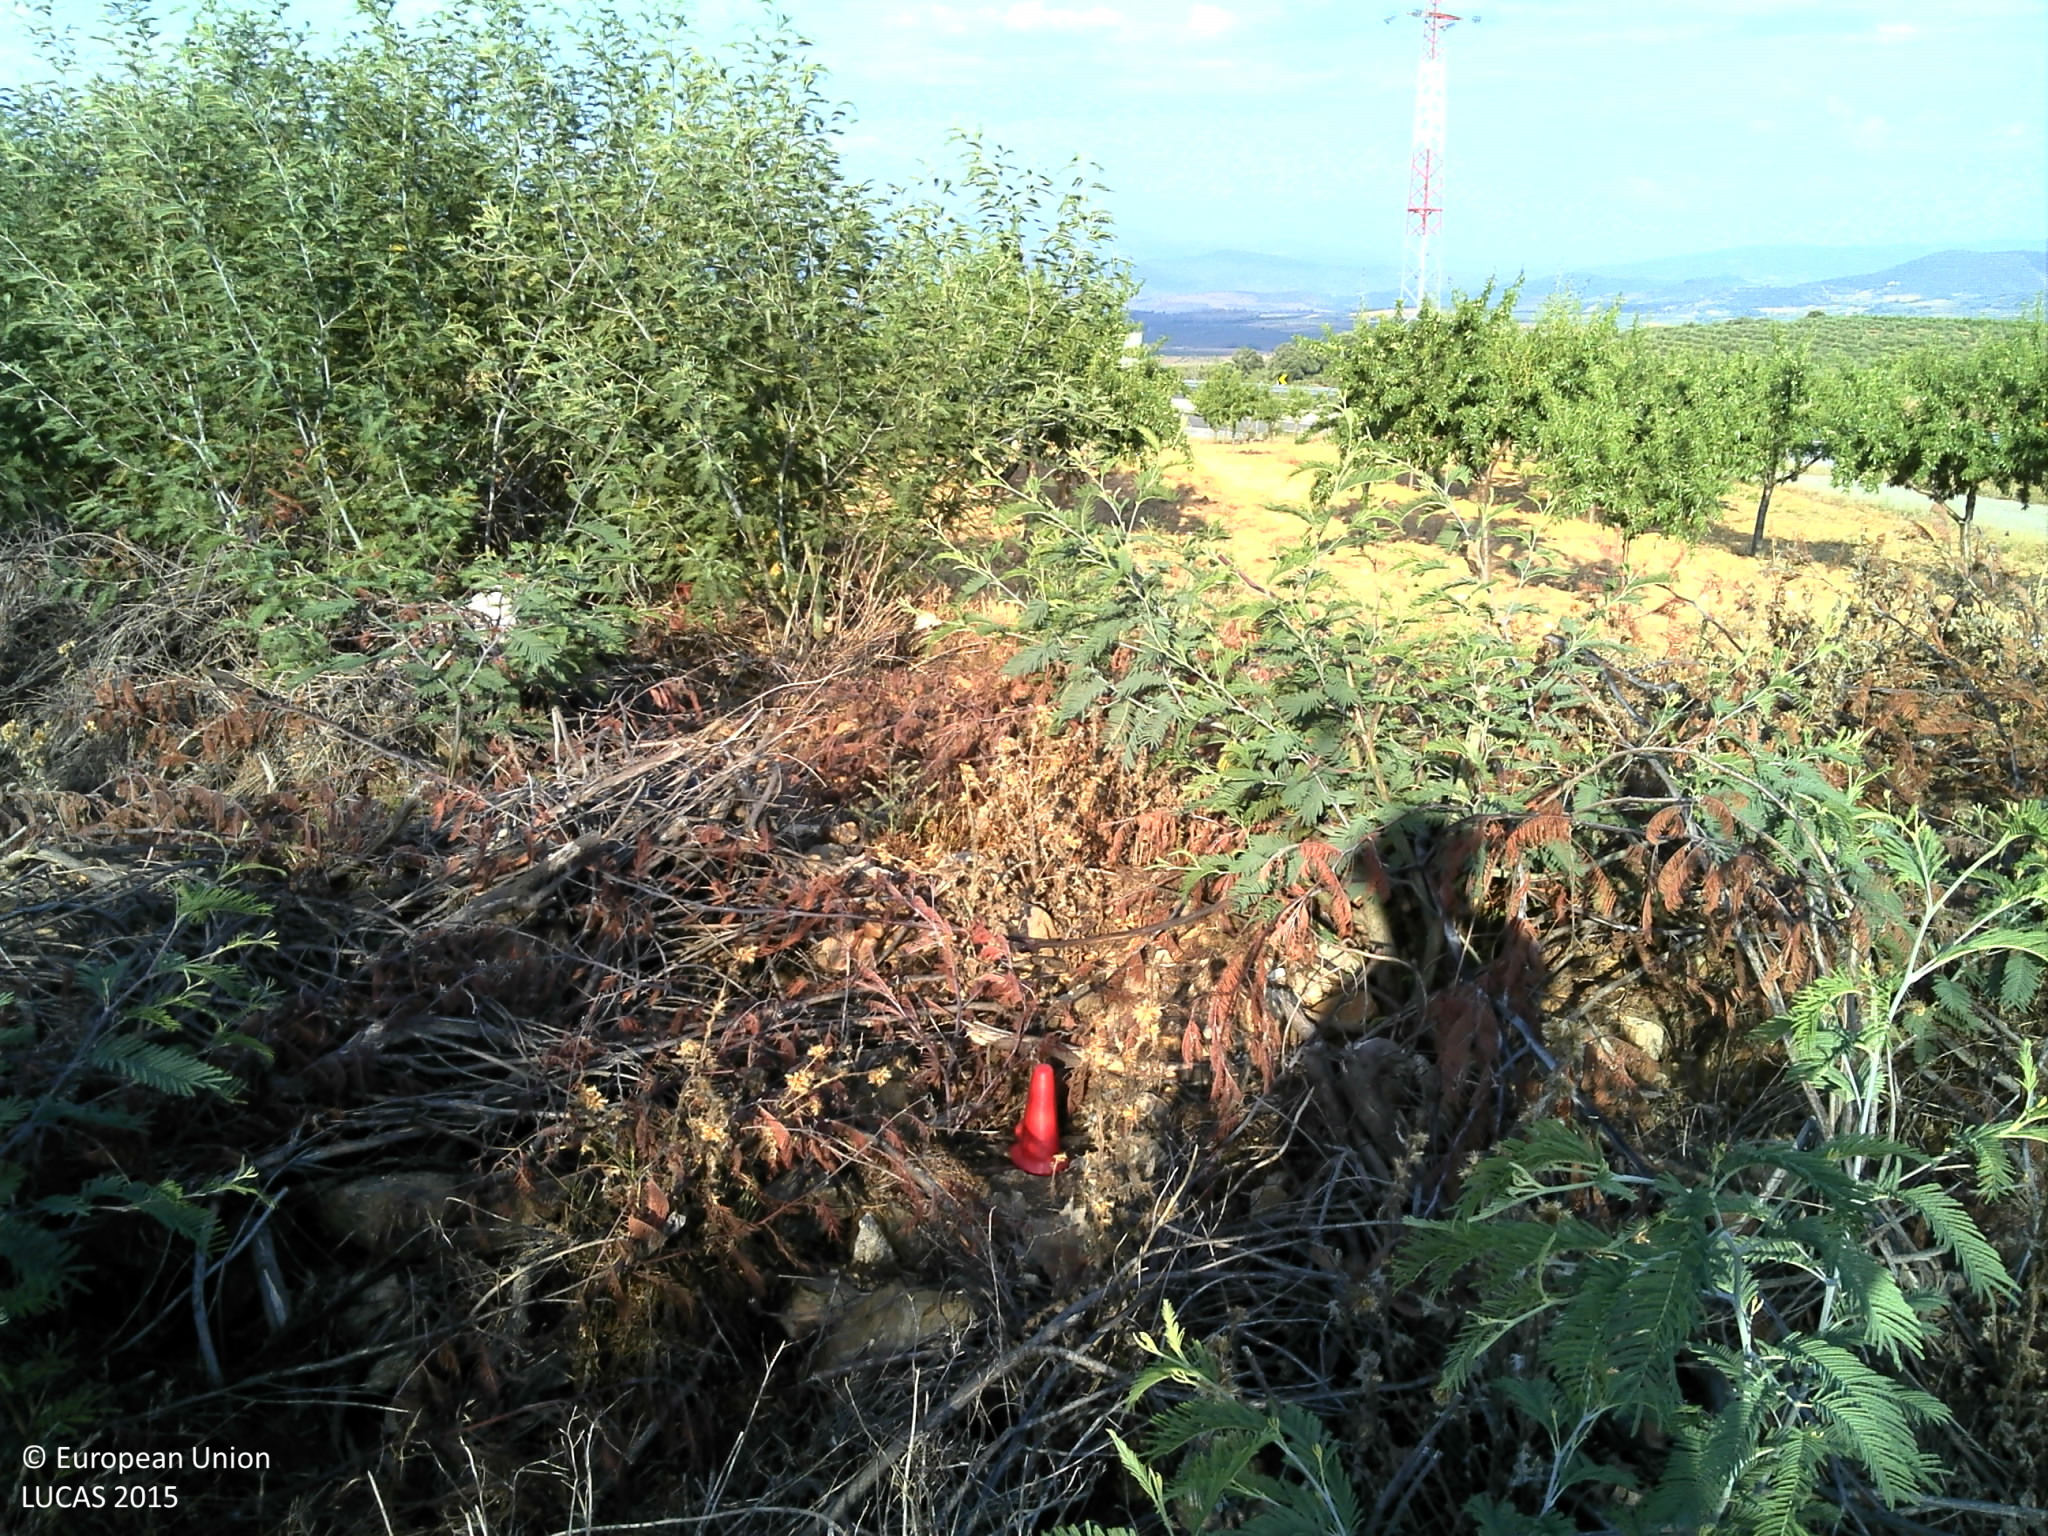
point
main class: Woodland
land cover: Broadleaved woodland
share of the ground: 10 - 25 %
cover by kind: unconsolidated bare surface 65 %, broadleaved forest trees 15 %, herbaceous plants 10 %, consolidated bare surface 10 %
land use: Semi-natural and natural areas not in use
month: June
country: PT
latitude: 41.4514
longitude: -7.2744
